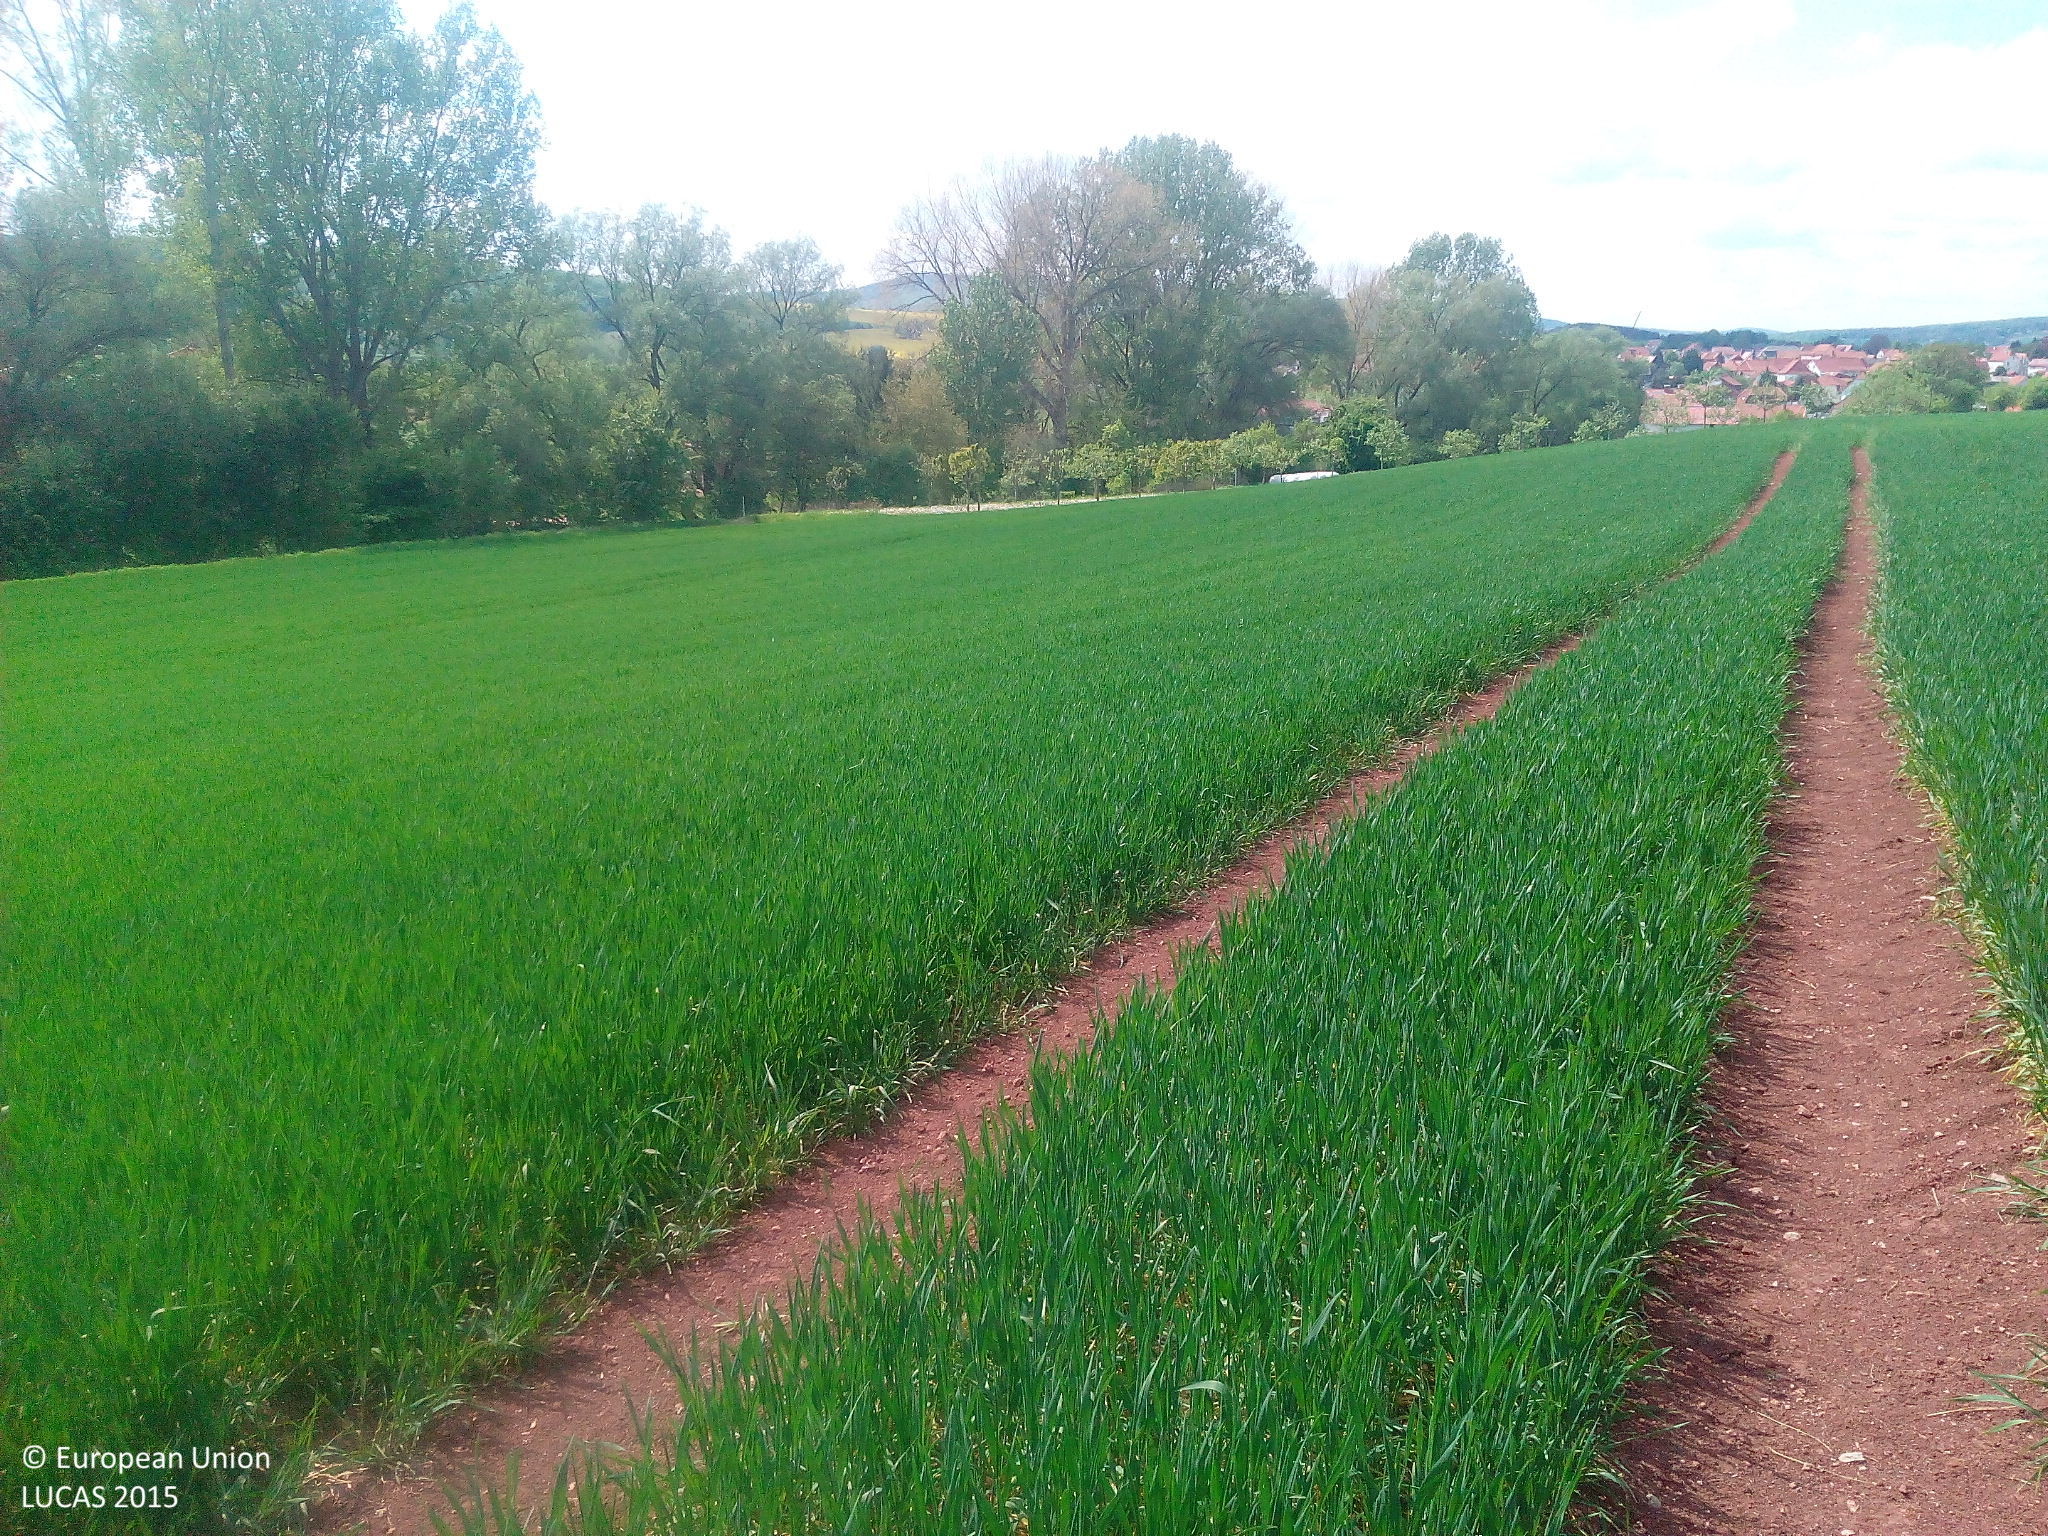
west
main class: Cropland
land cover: Triticale
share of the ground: > 75 %
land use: Agriculture (excluding fallow land and kitchen gardens)
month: May
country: DE
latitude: 51.3708
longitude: 9.9569
